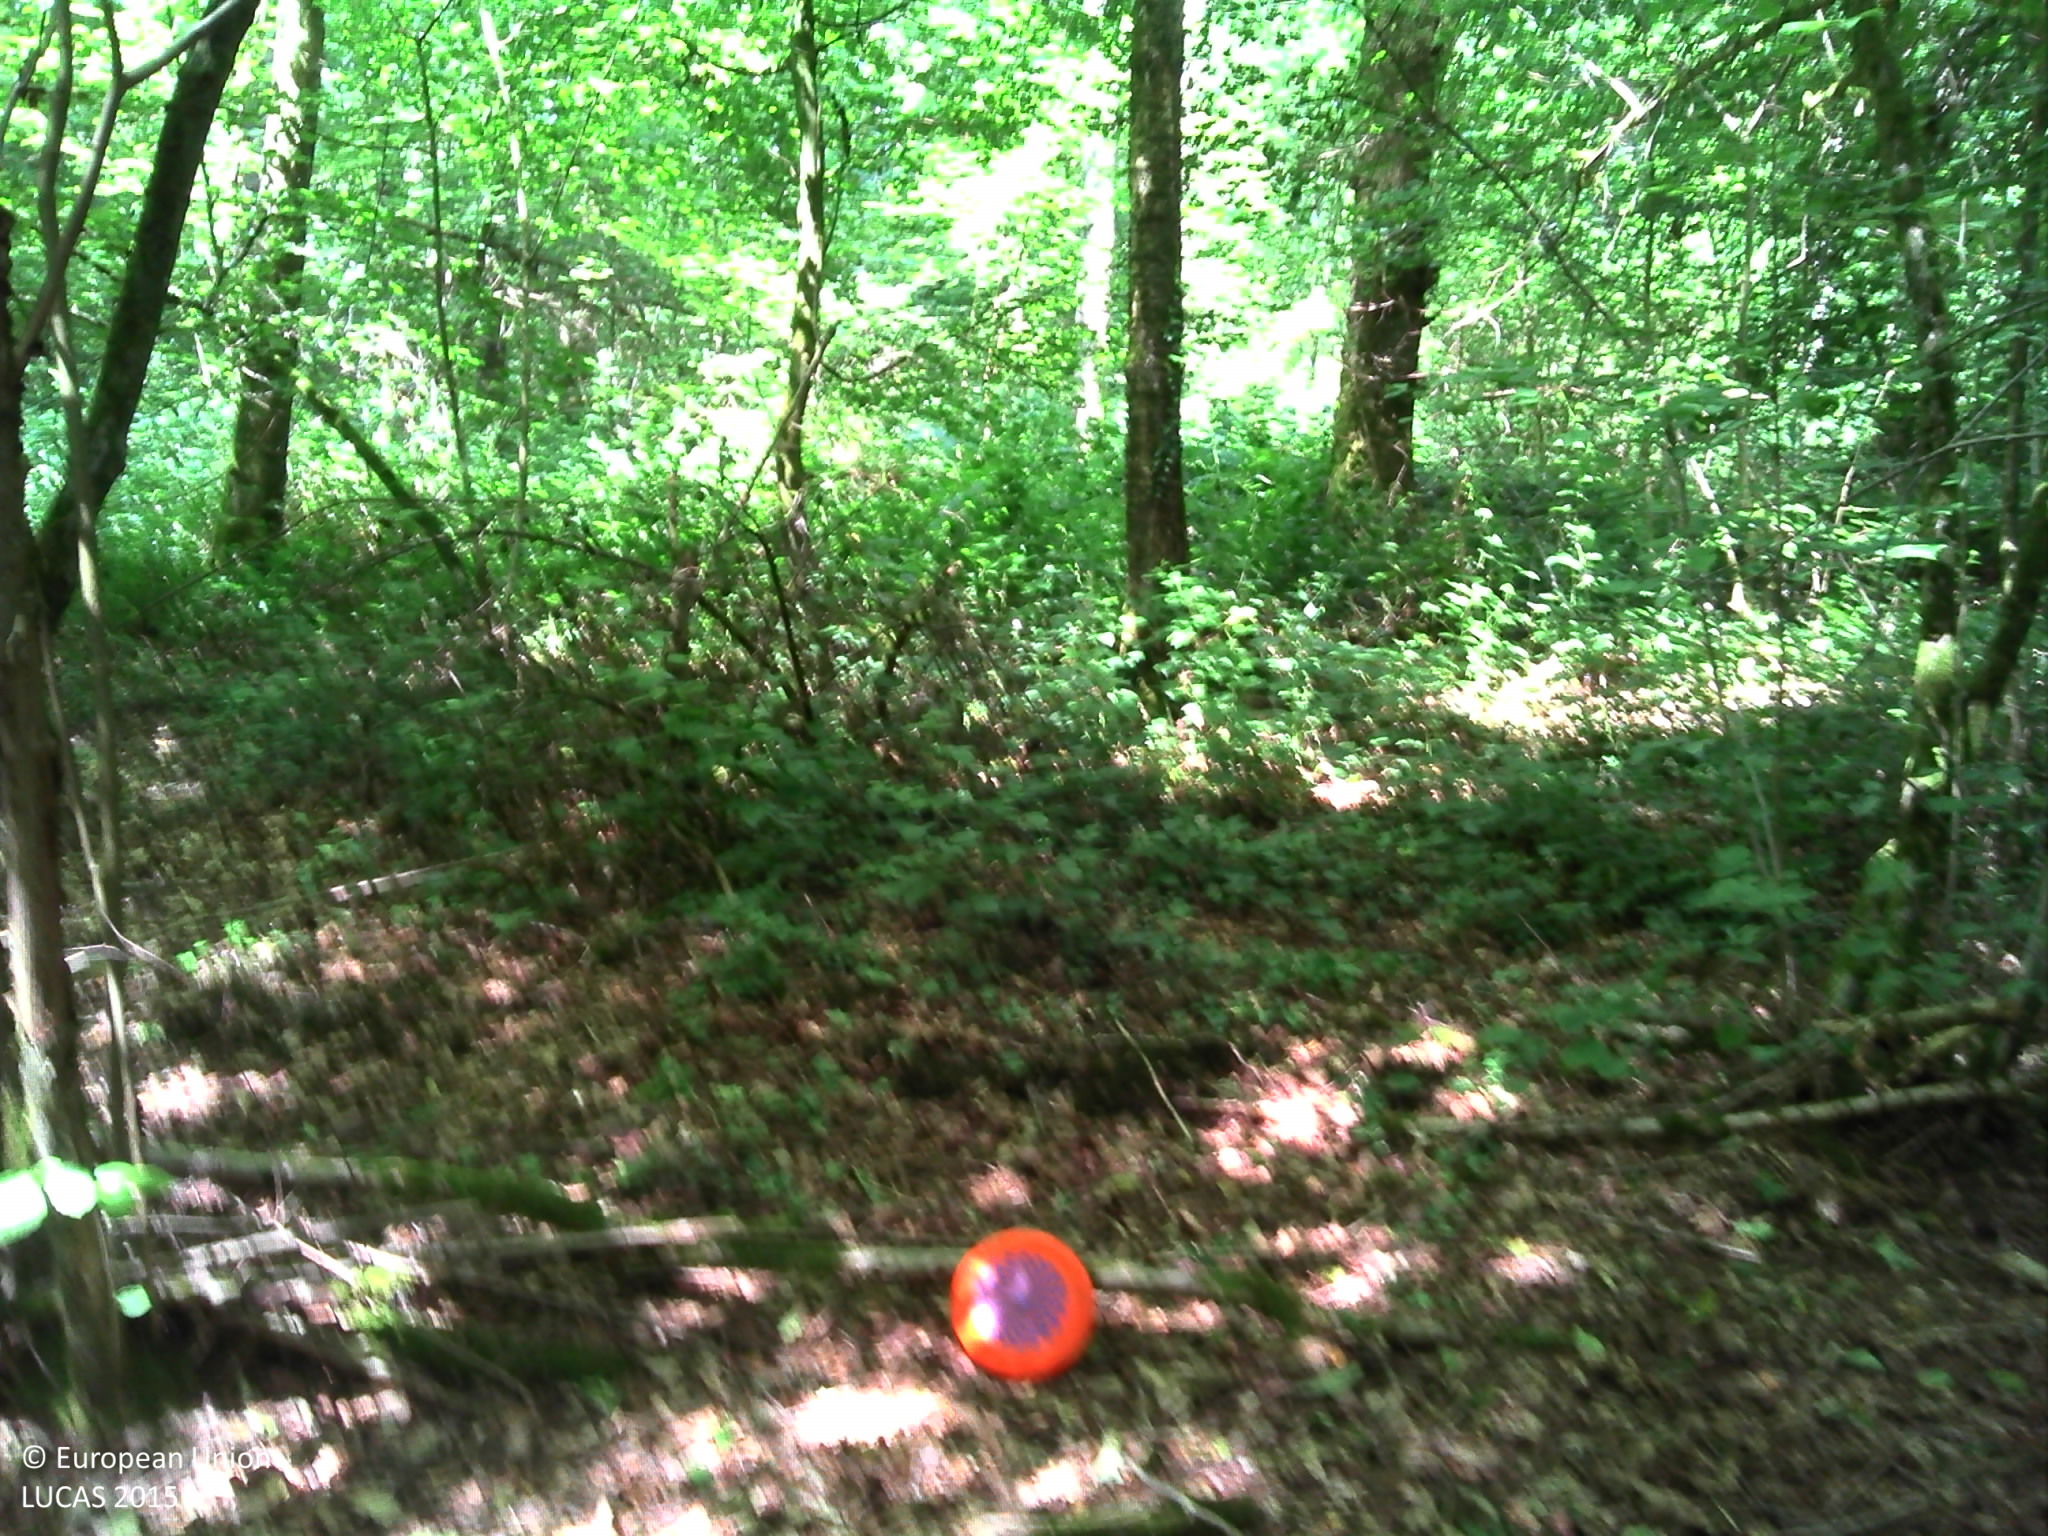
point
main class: Woodland
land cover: Broadleaved woodland
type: mesophytic deciduous forest
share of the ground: > 75 %
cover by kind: broadleaved forest trees 95 %, herbaceous plants 5 %
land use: Forestry
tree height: > 5 m
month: July
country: BE
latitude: 50.2172
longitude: 4.5725
